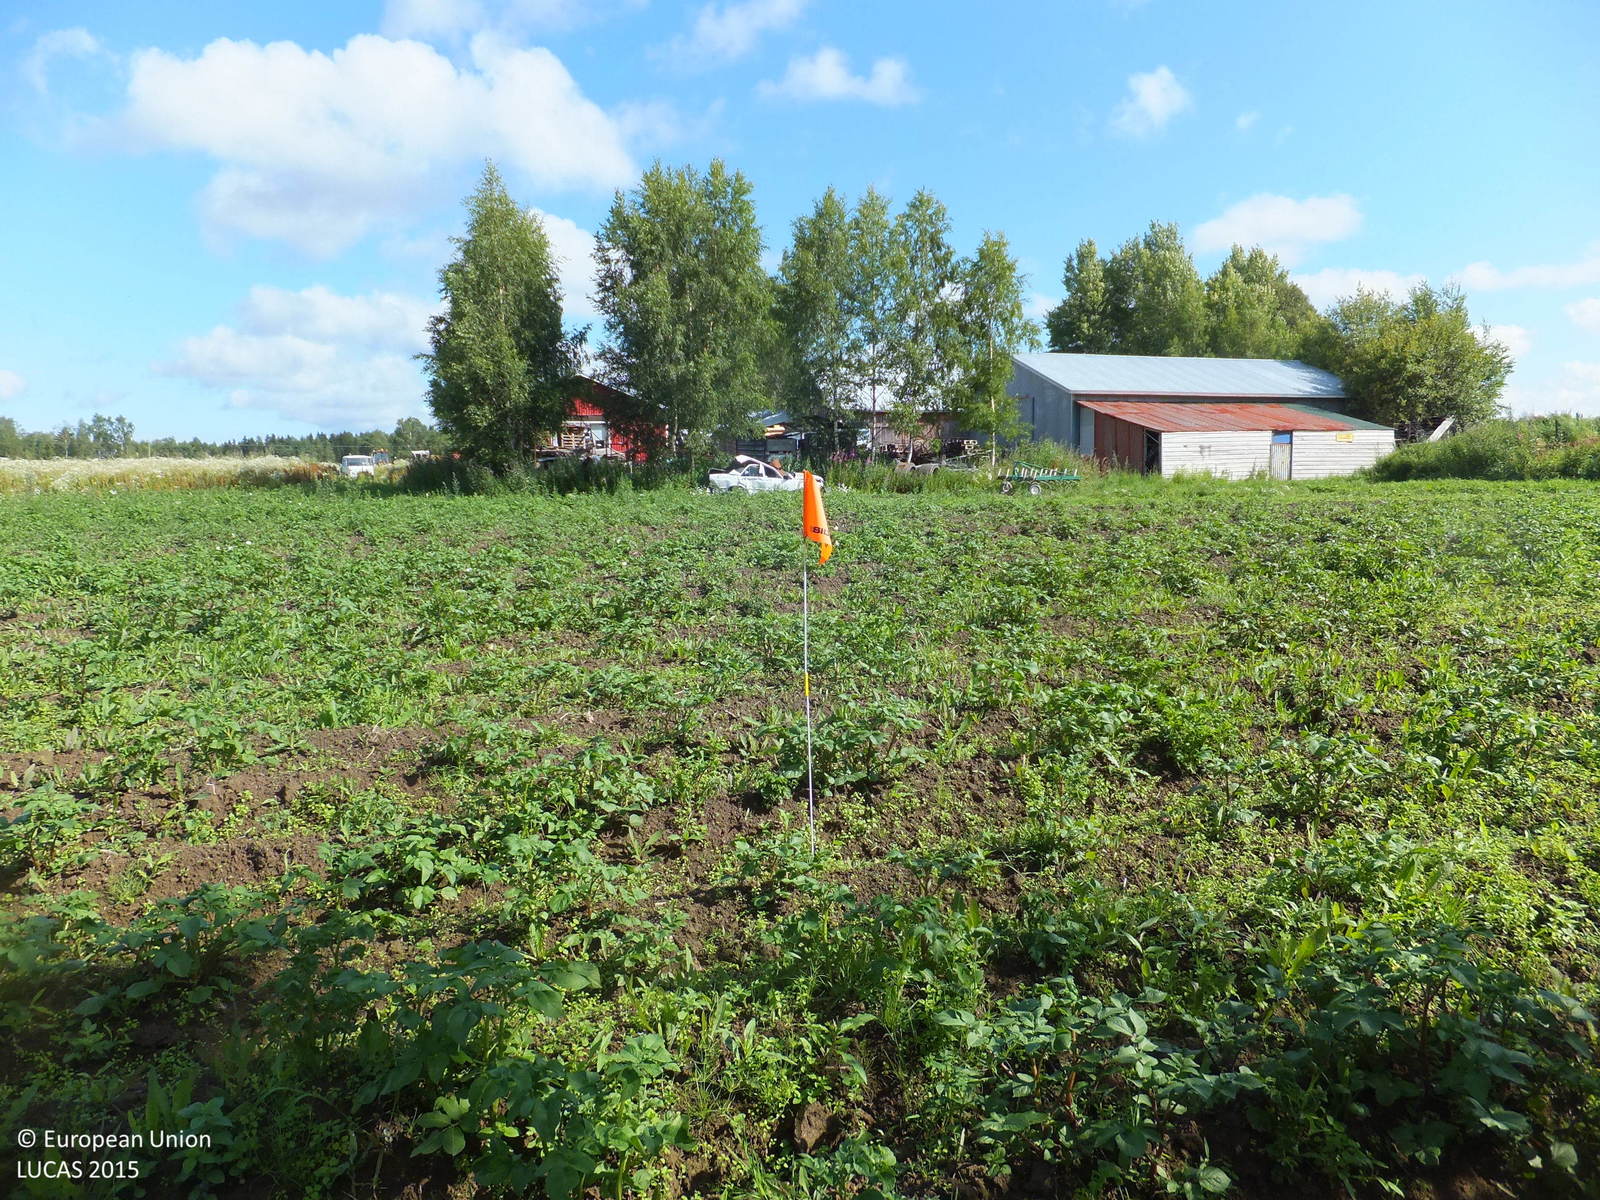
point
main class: Cropland
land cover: Potatoes
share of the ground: 25 - 50 %
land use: Agriculture (excluding fallow land and kitchen gardens)
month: July
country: FI
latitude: 63.1836
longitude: 21.6227
